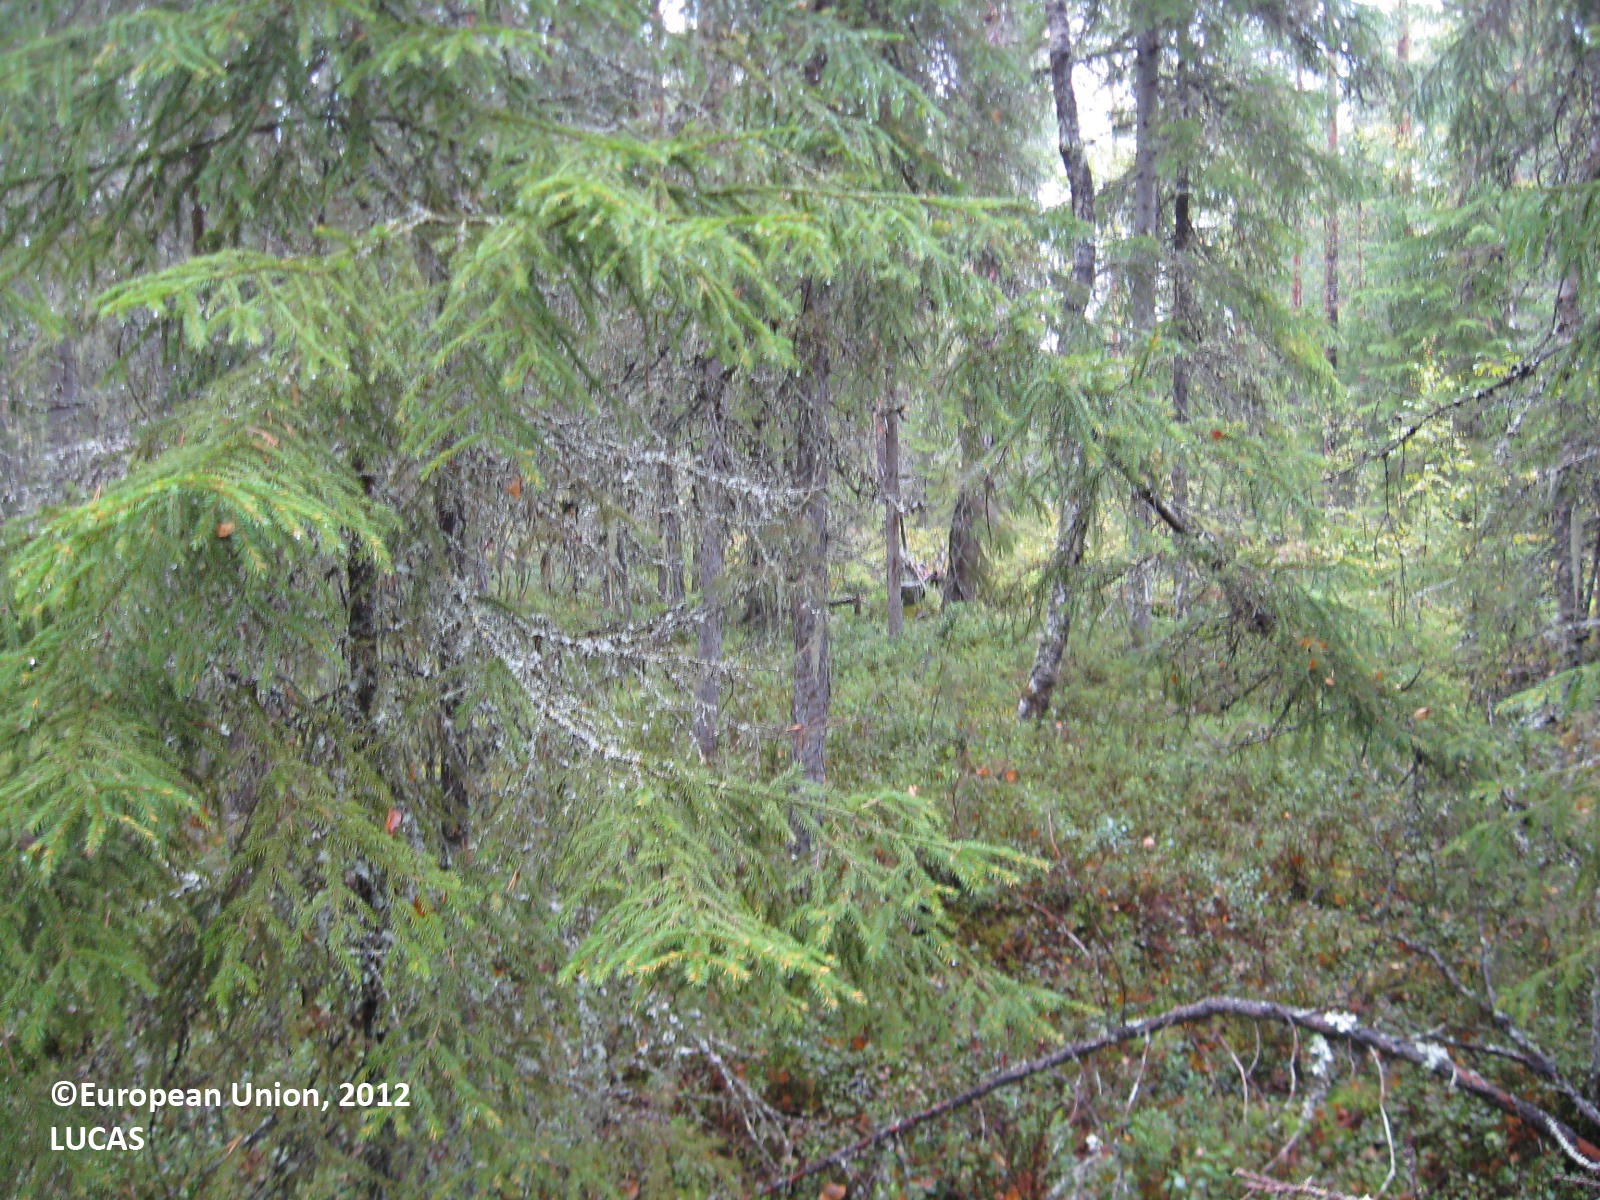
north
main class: Woodland
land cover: Other coniferous woodland
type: boreal forest
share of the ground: > 75 %
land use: Forestry
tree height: > 5 m
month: August
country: FI
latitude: 63.5250
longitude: 29.6340
